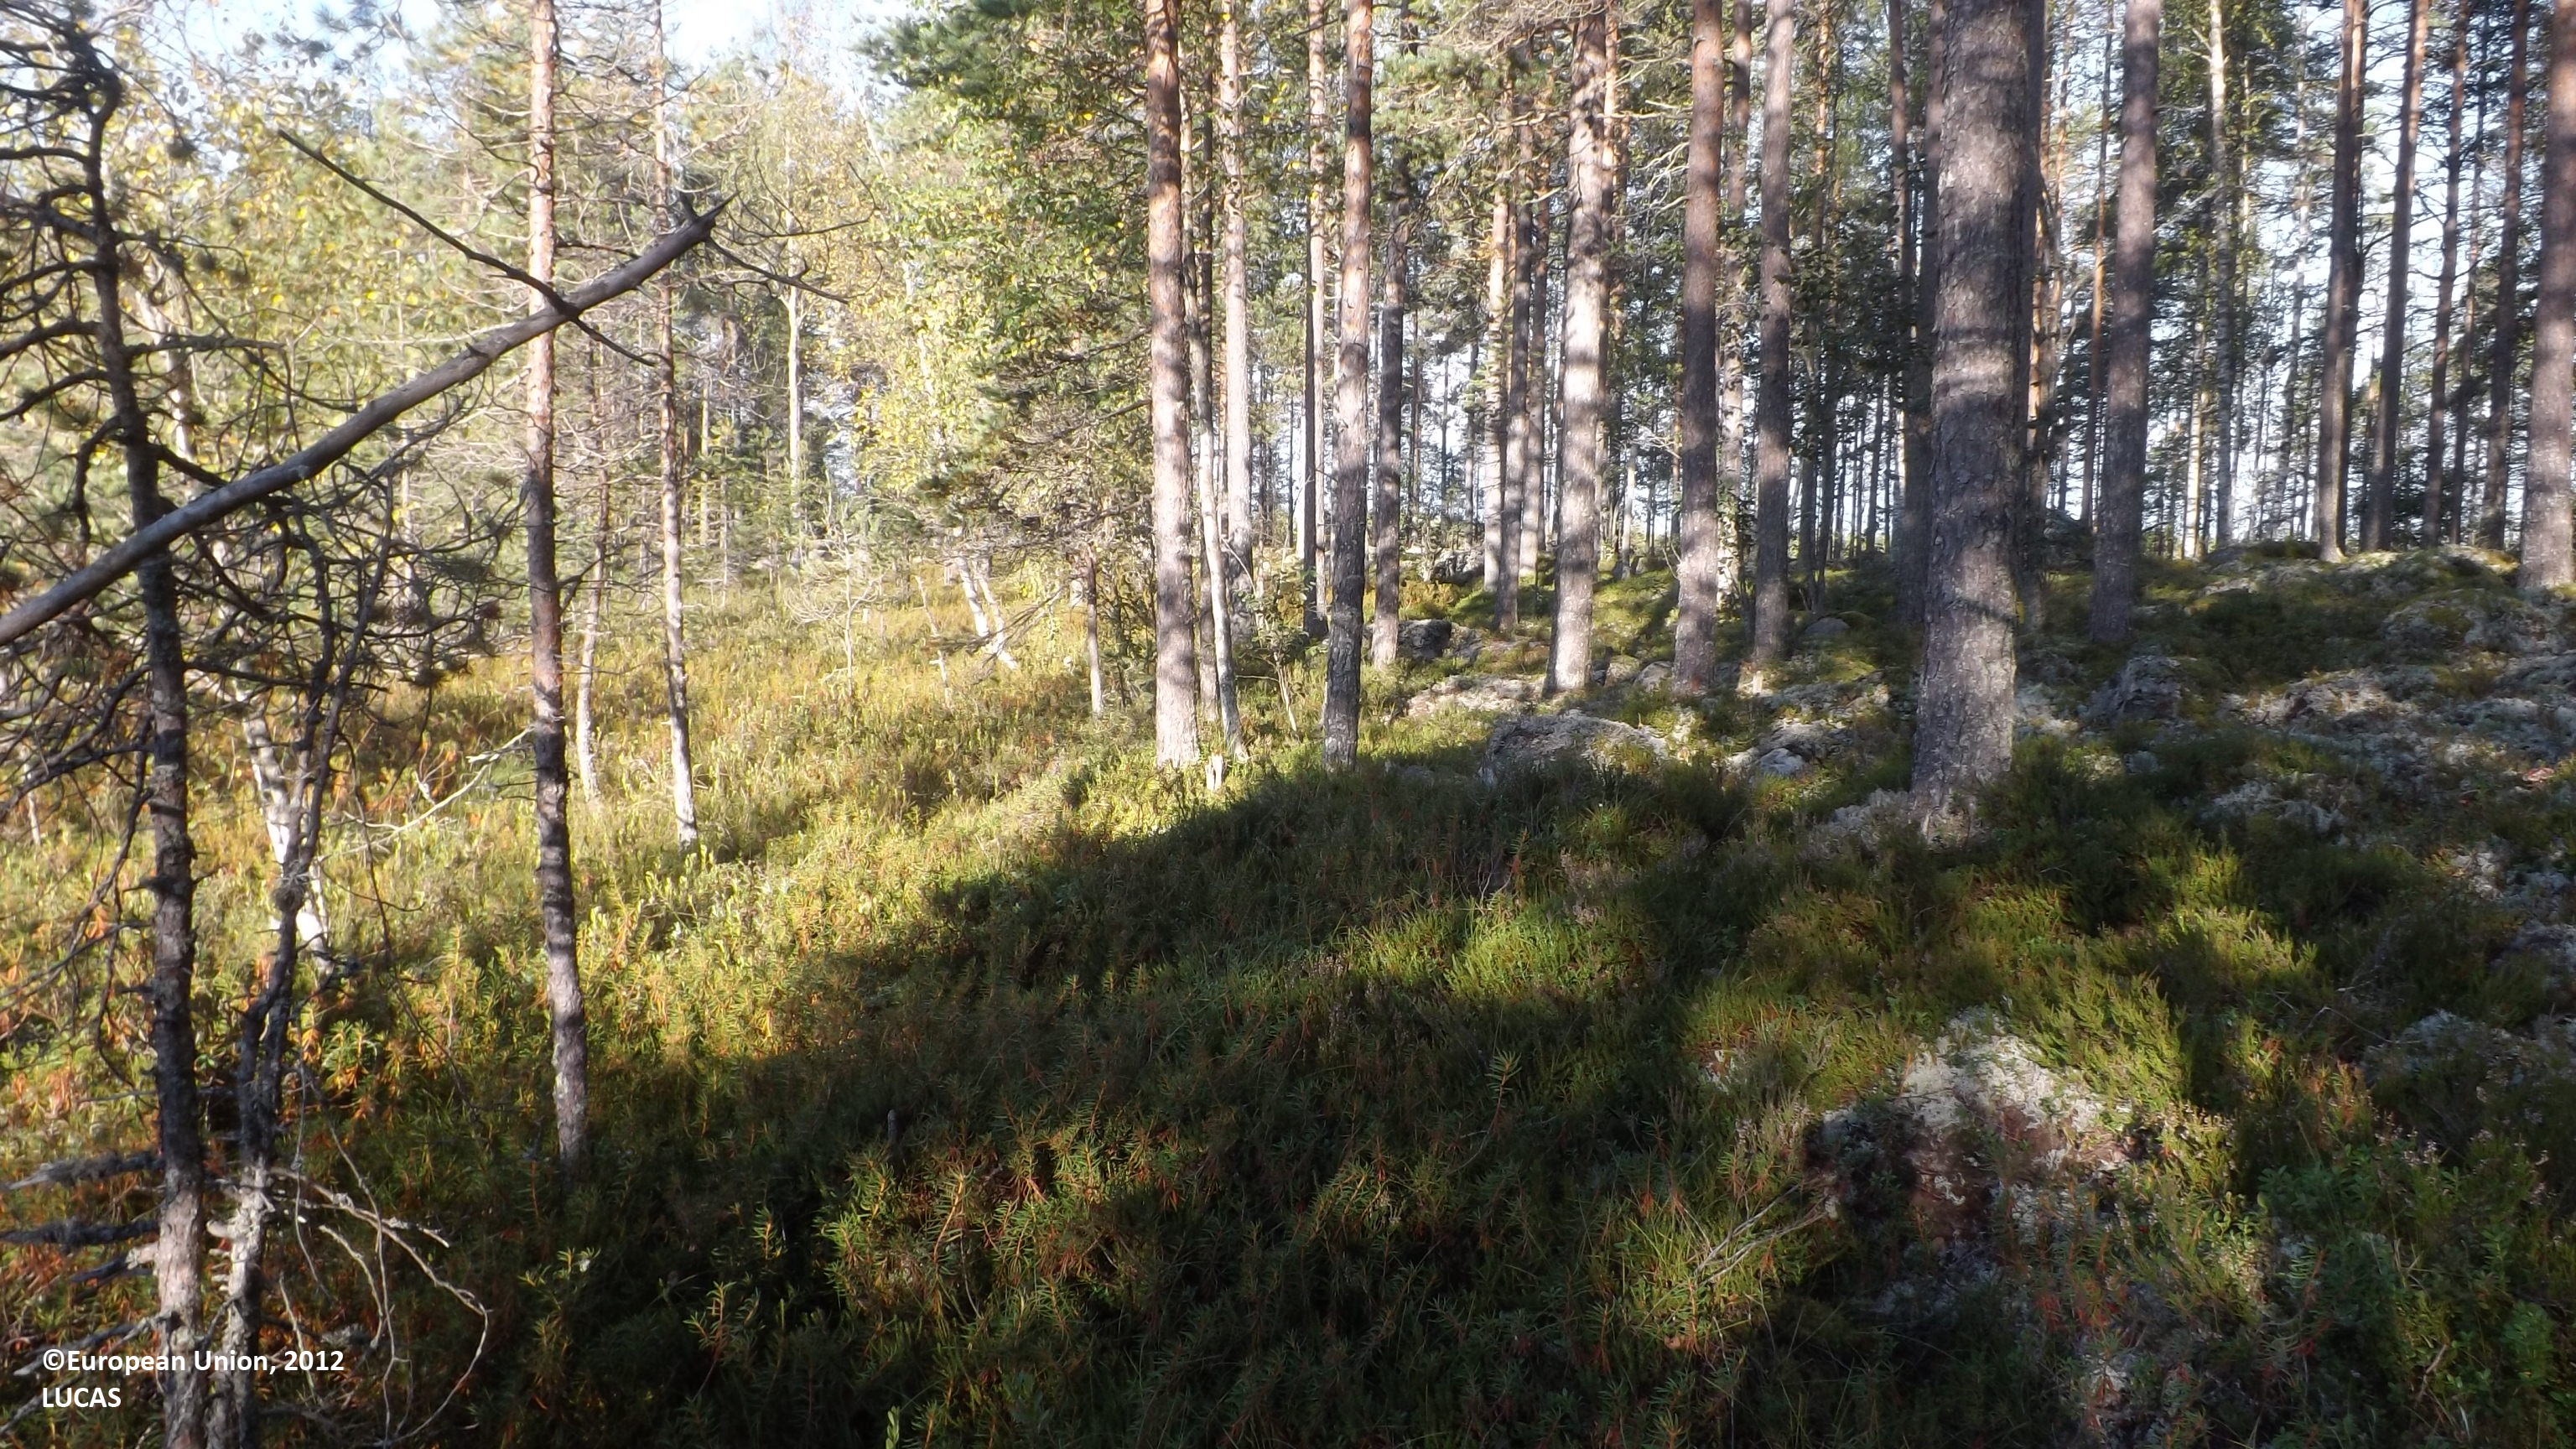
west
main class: Woodland
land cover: Pine dominated coniferous woodland
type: boreal forest
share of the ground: 25 - 50 %
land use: Forestry
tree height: > 5 m
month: August
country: FI
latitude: 63.7486
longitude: 24.0718
